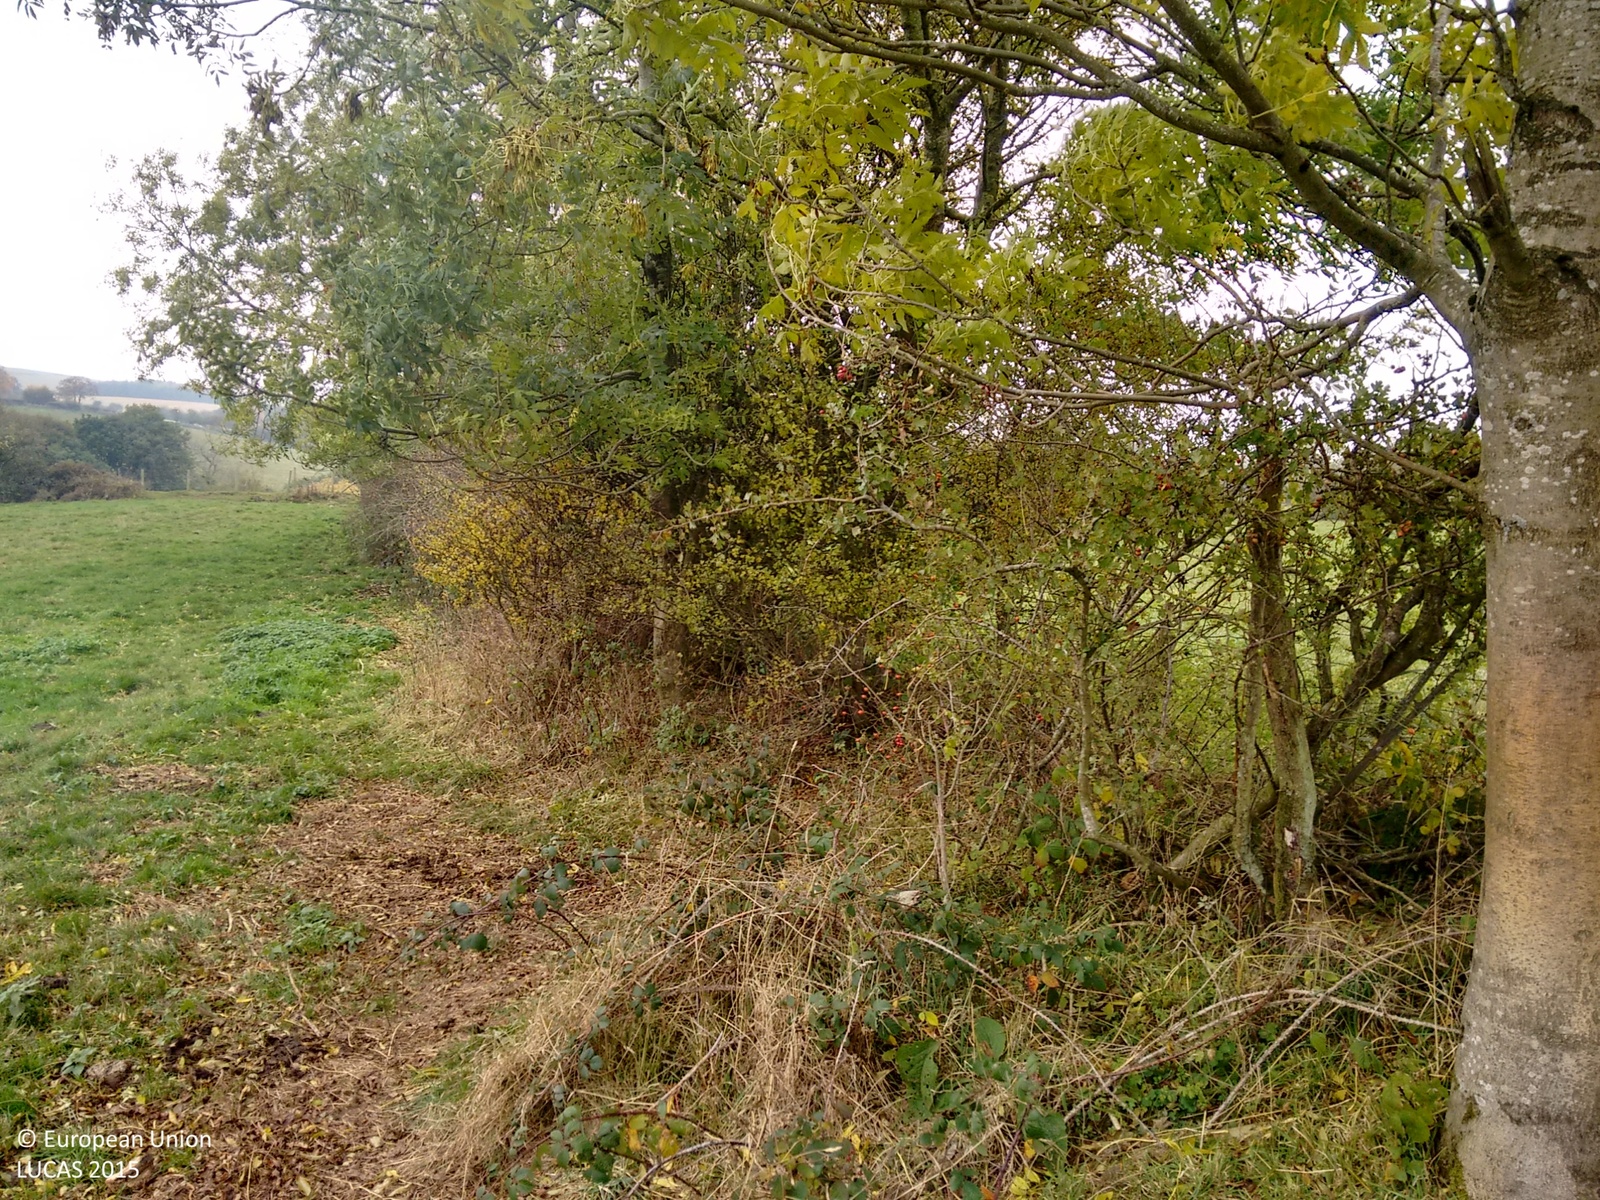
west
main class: Grassland
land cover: Grassland without tree/shrub cover
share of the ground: > 75 %
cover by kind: herbaceous plants 100 %
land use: Agriculture (excluding fallow land and kitchen gardens)
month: October
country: GB
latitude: 52.5873
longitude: -2.8395
